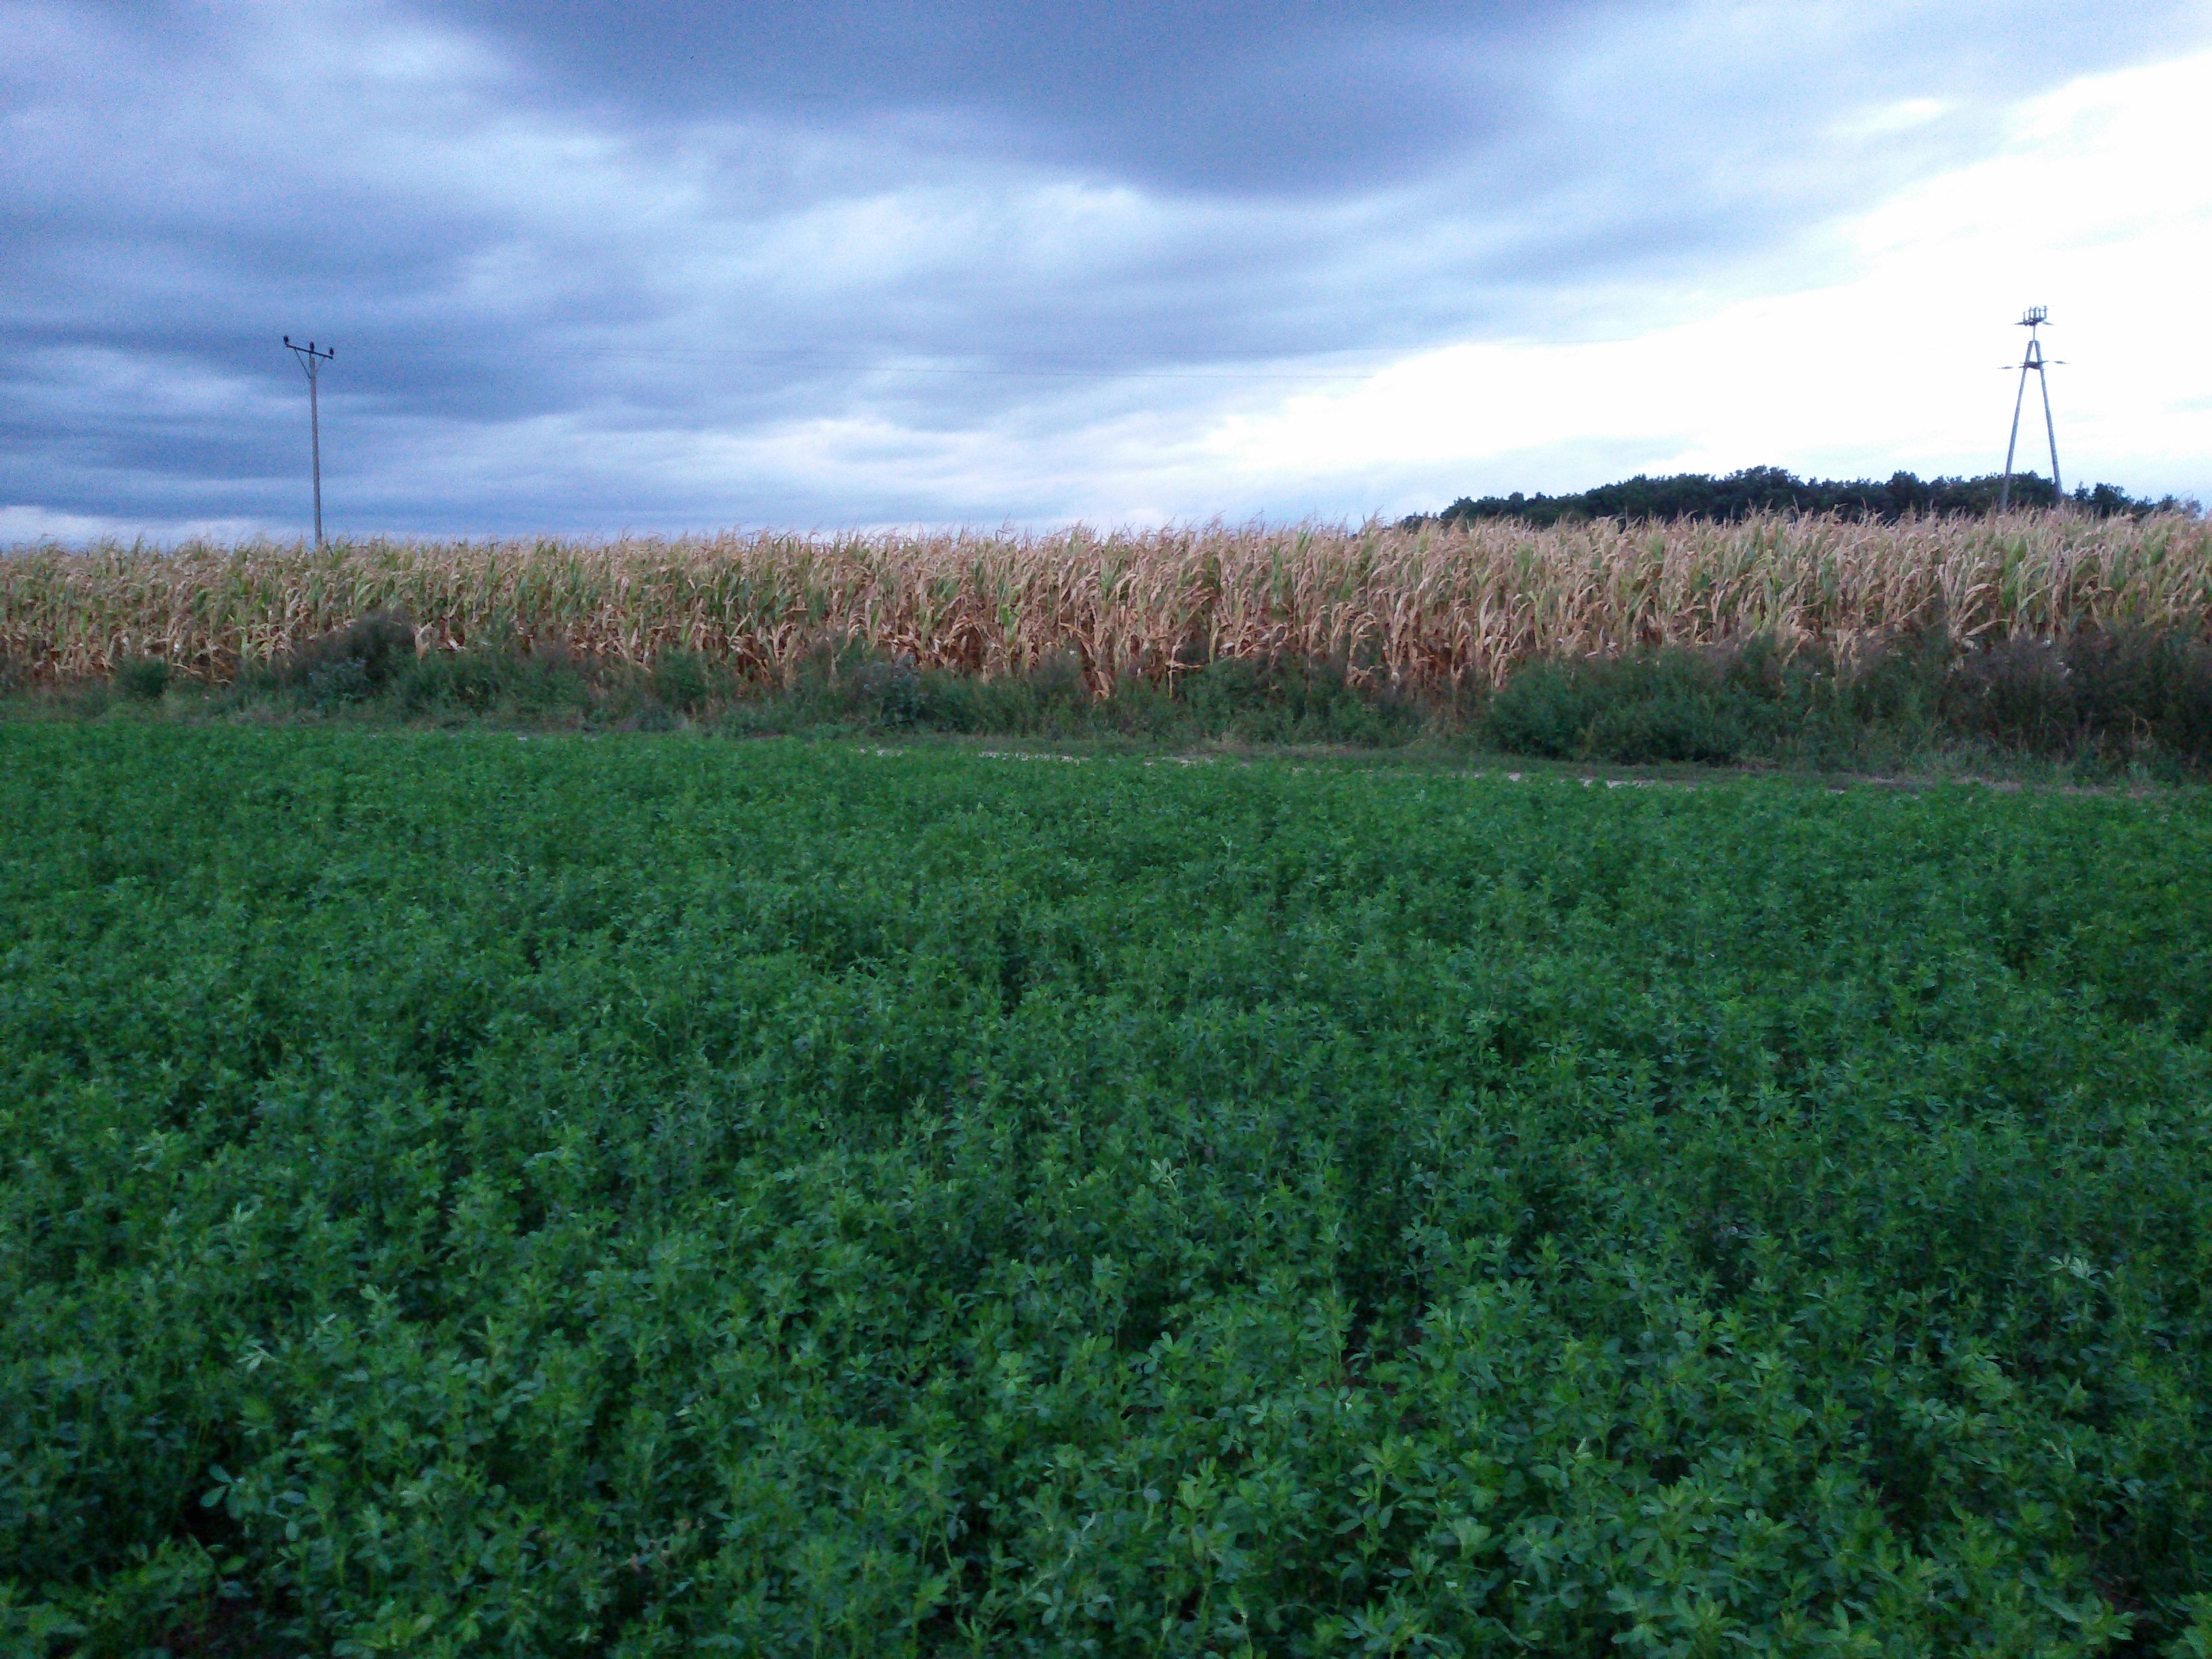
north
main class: Cropland
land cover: Lucerne
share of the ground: > 75 %
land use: Agriculture (excluding fallow land and kitchen gardens)
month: September
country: PL
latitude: 53.0147
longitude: 17.6597
